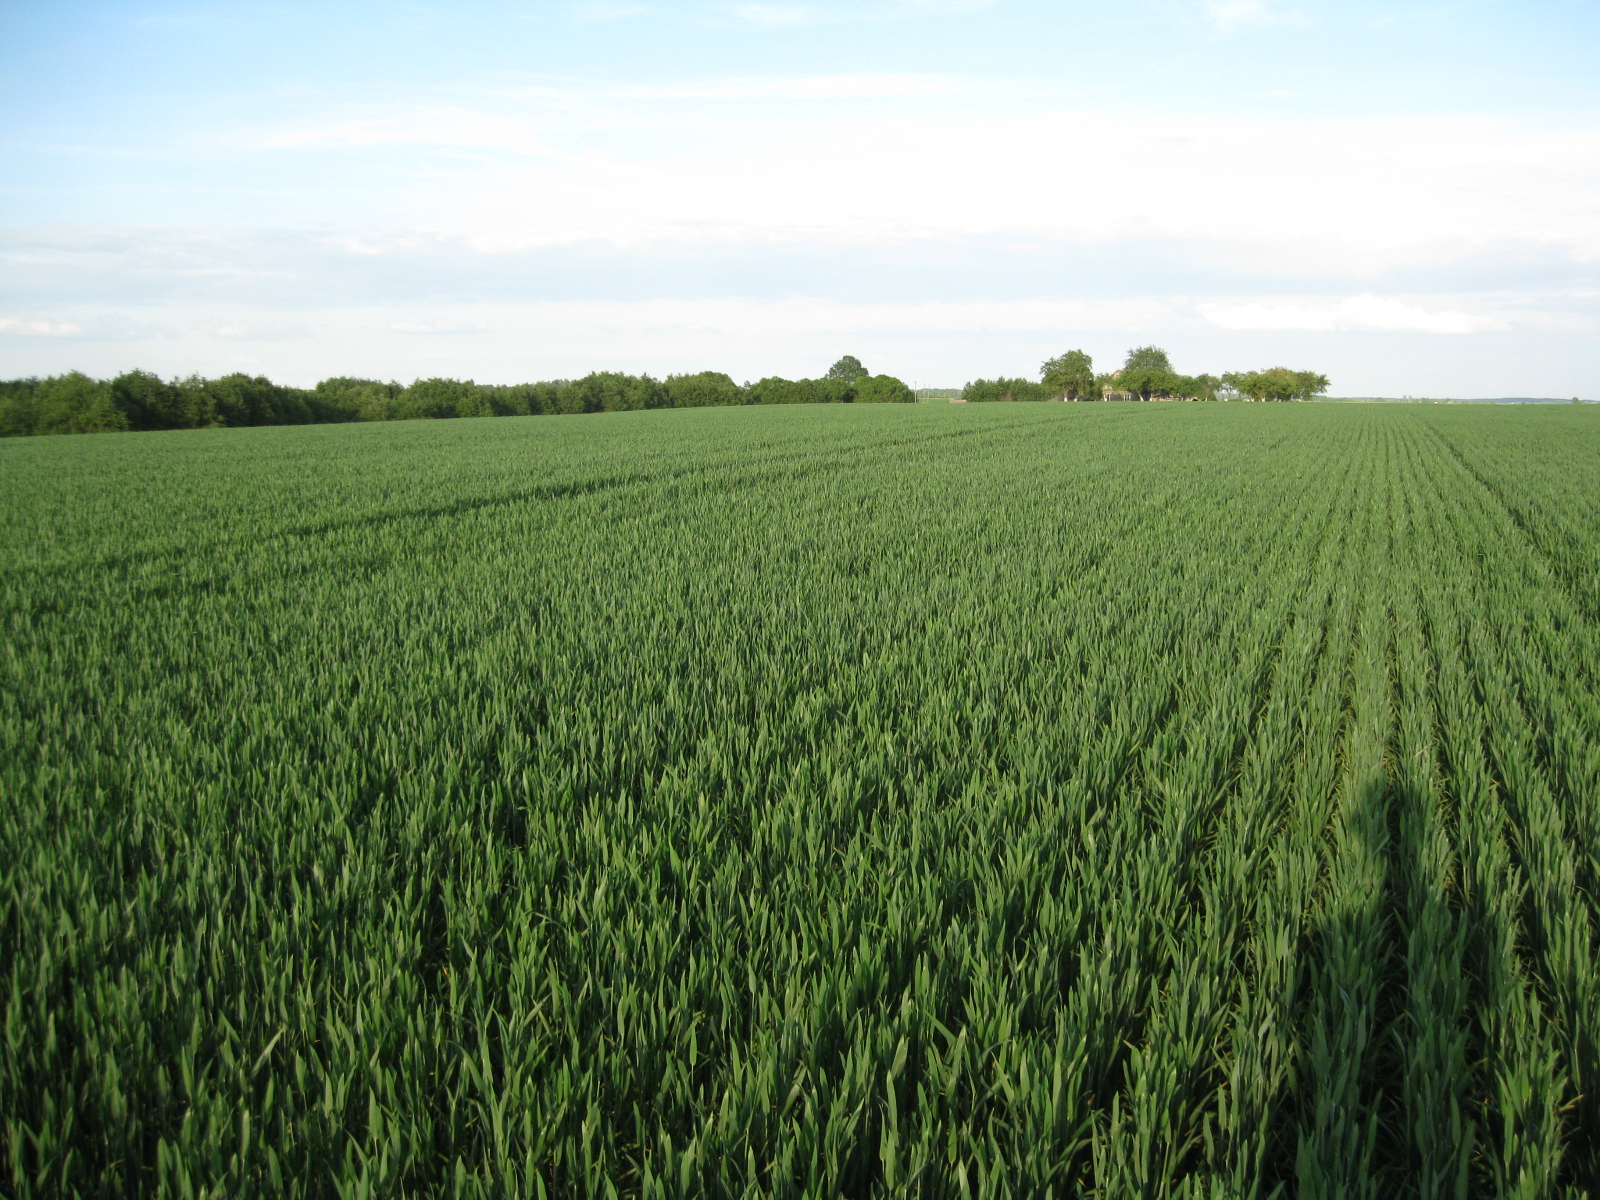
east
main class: Cropland
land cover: Common wheat
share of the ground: > 75 %
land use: Agriculture (excluding fallow land and kitchen gardens)
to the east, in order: Common wheat
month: June
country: LT
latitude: 55.1575
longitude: 23.8514
